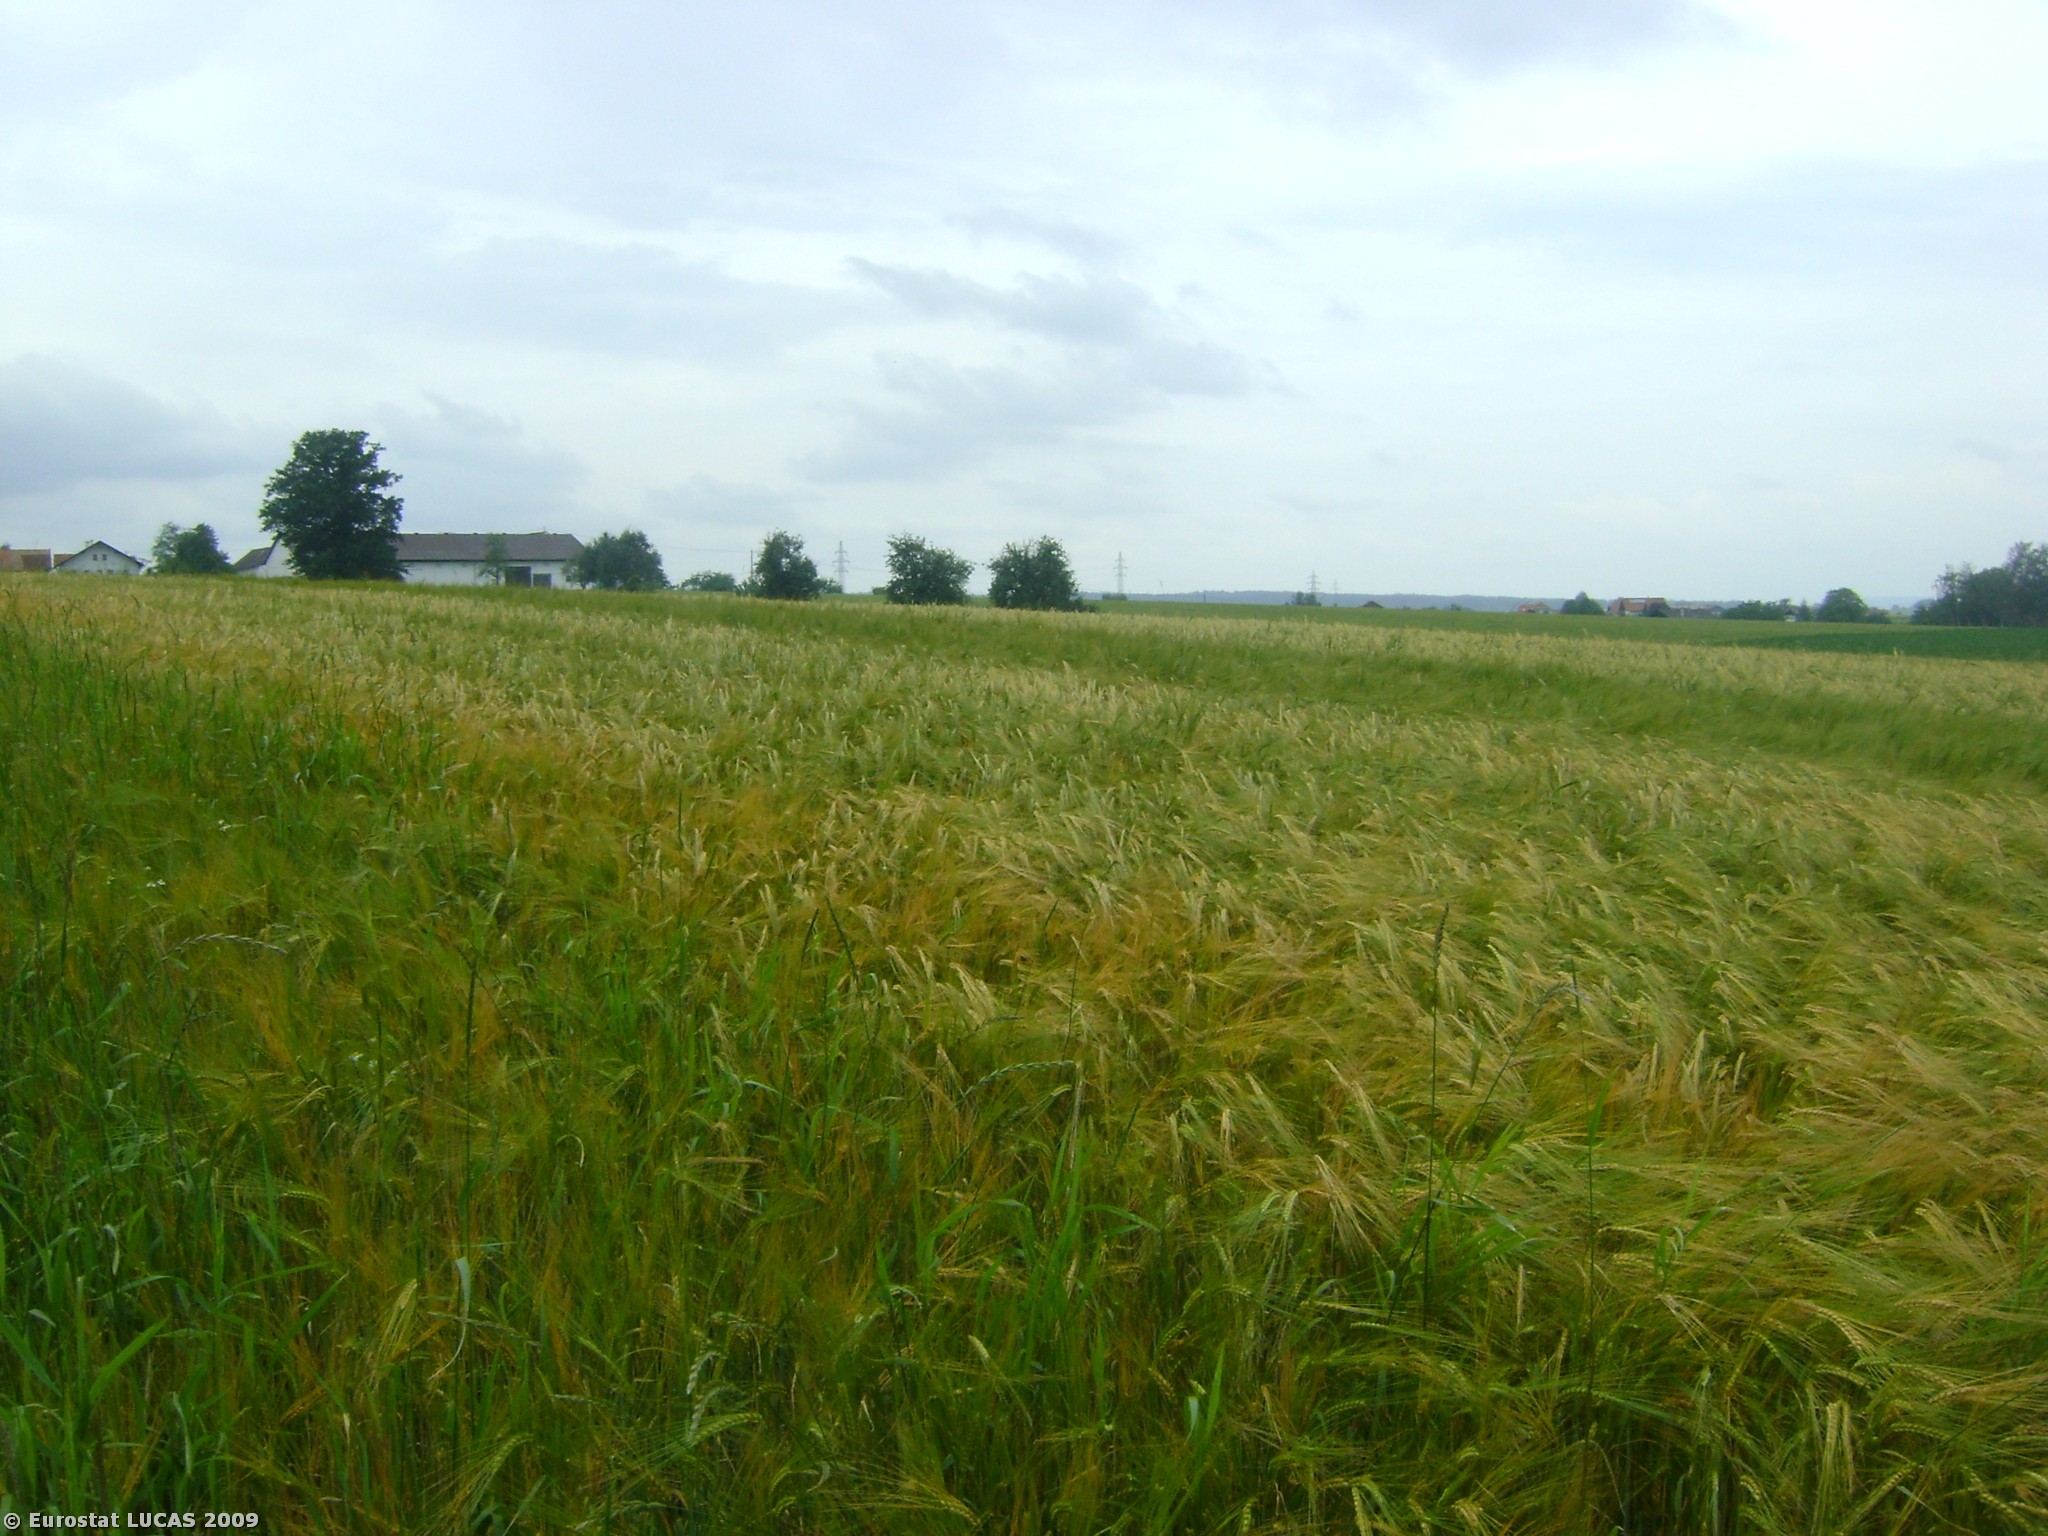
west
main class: Cropland
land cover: Barley
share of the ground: > 75 %
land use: Agriculture (excluding fallow land and kitchen gardens)
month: June
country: AT
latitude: 48.1915
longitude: 13.3219
